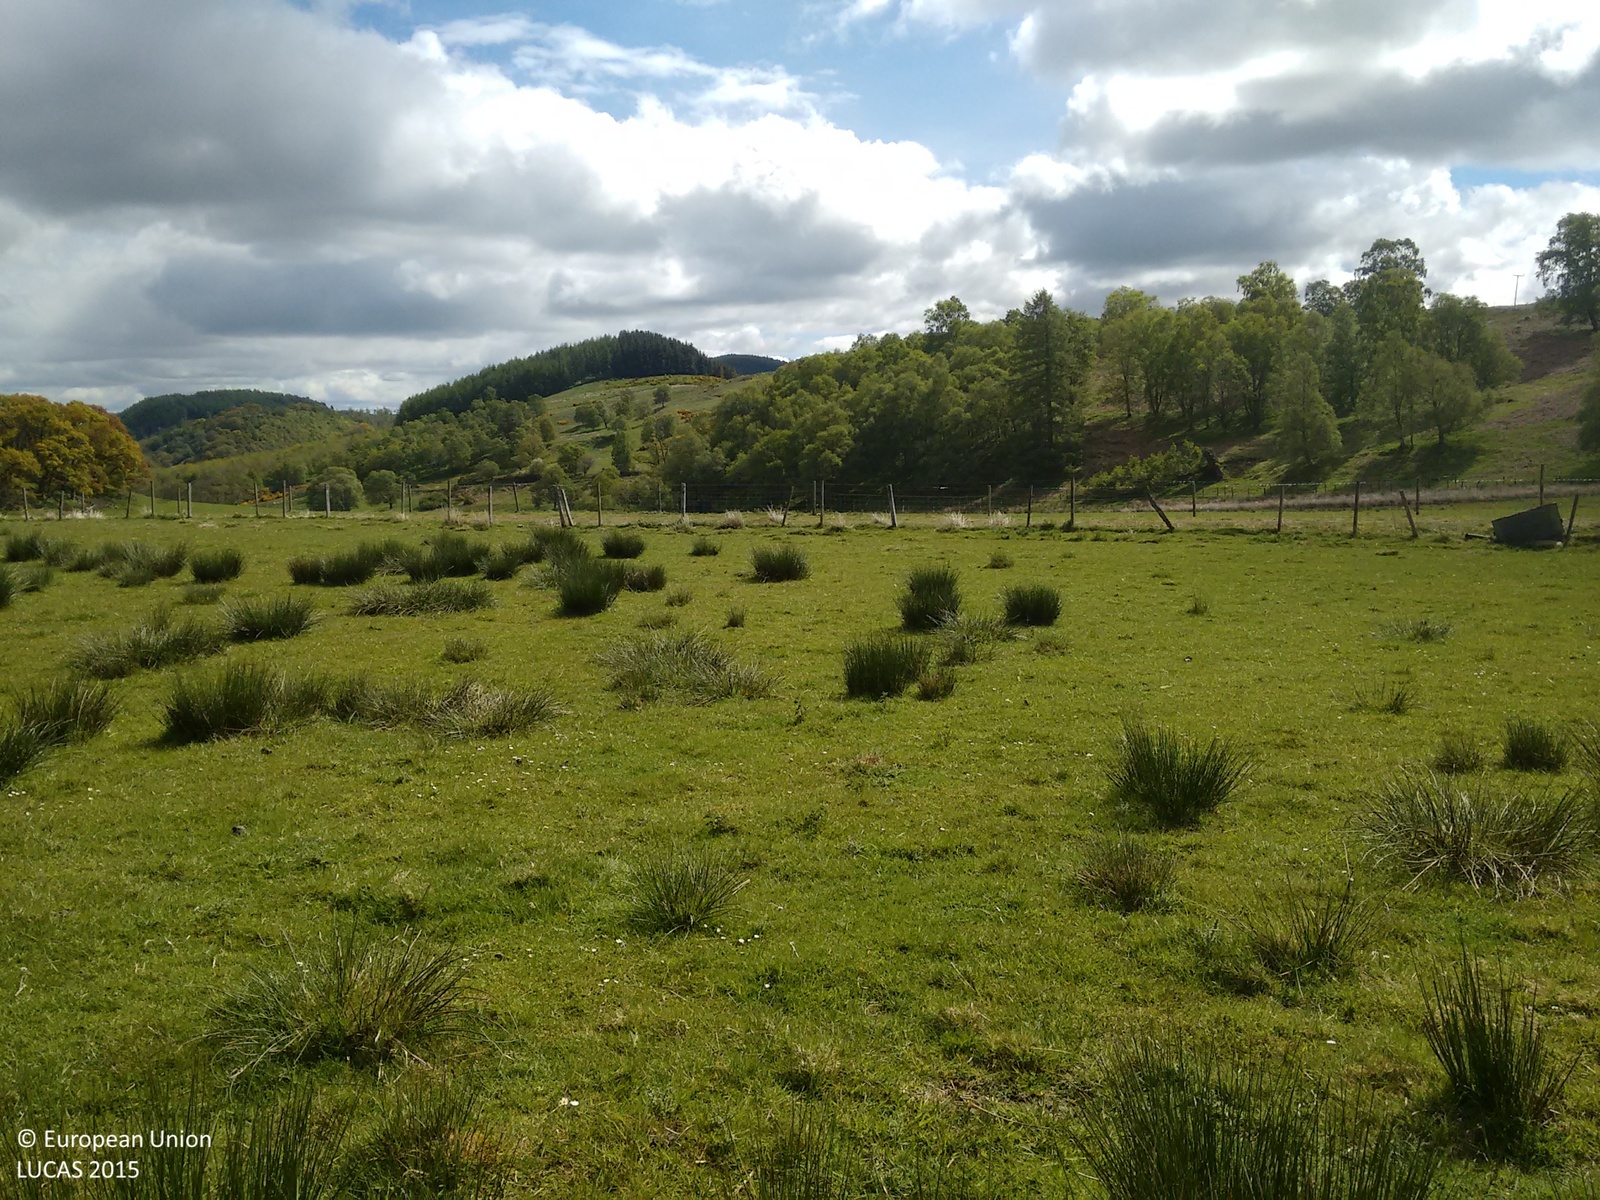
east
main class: Grassland
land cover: Grassland without tree/shrub cover
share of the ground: > 75 %
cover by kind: herbaceous plants 100 %
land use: Agriculture (excluding fallow land and kitchen gardens)
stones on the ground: < 10 %
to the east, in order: Grassland without tree/shrub cover; Fences; Ditches and canals; Tracks; Grass margins; Fences; Grassland without tree/shrub cover; Fences; Broadleaved woodland
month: May
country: GB
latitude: 56.3491
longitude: -3.9850
